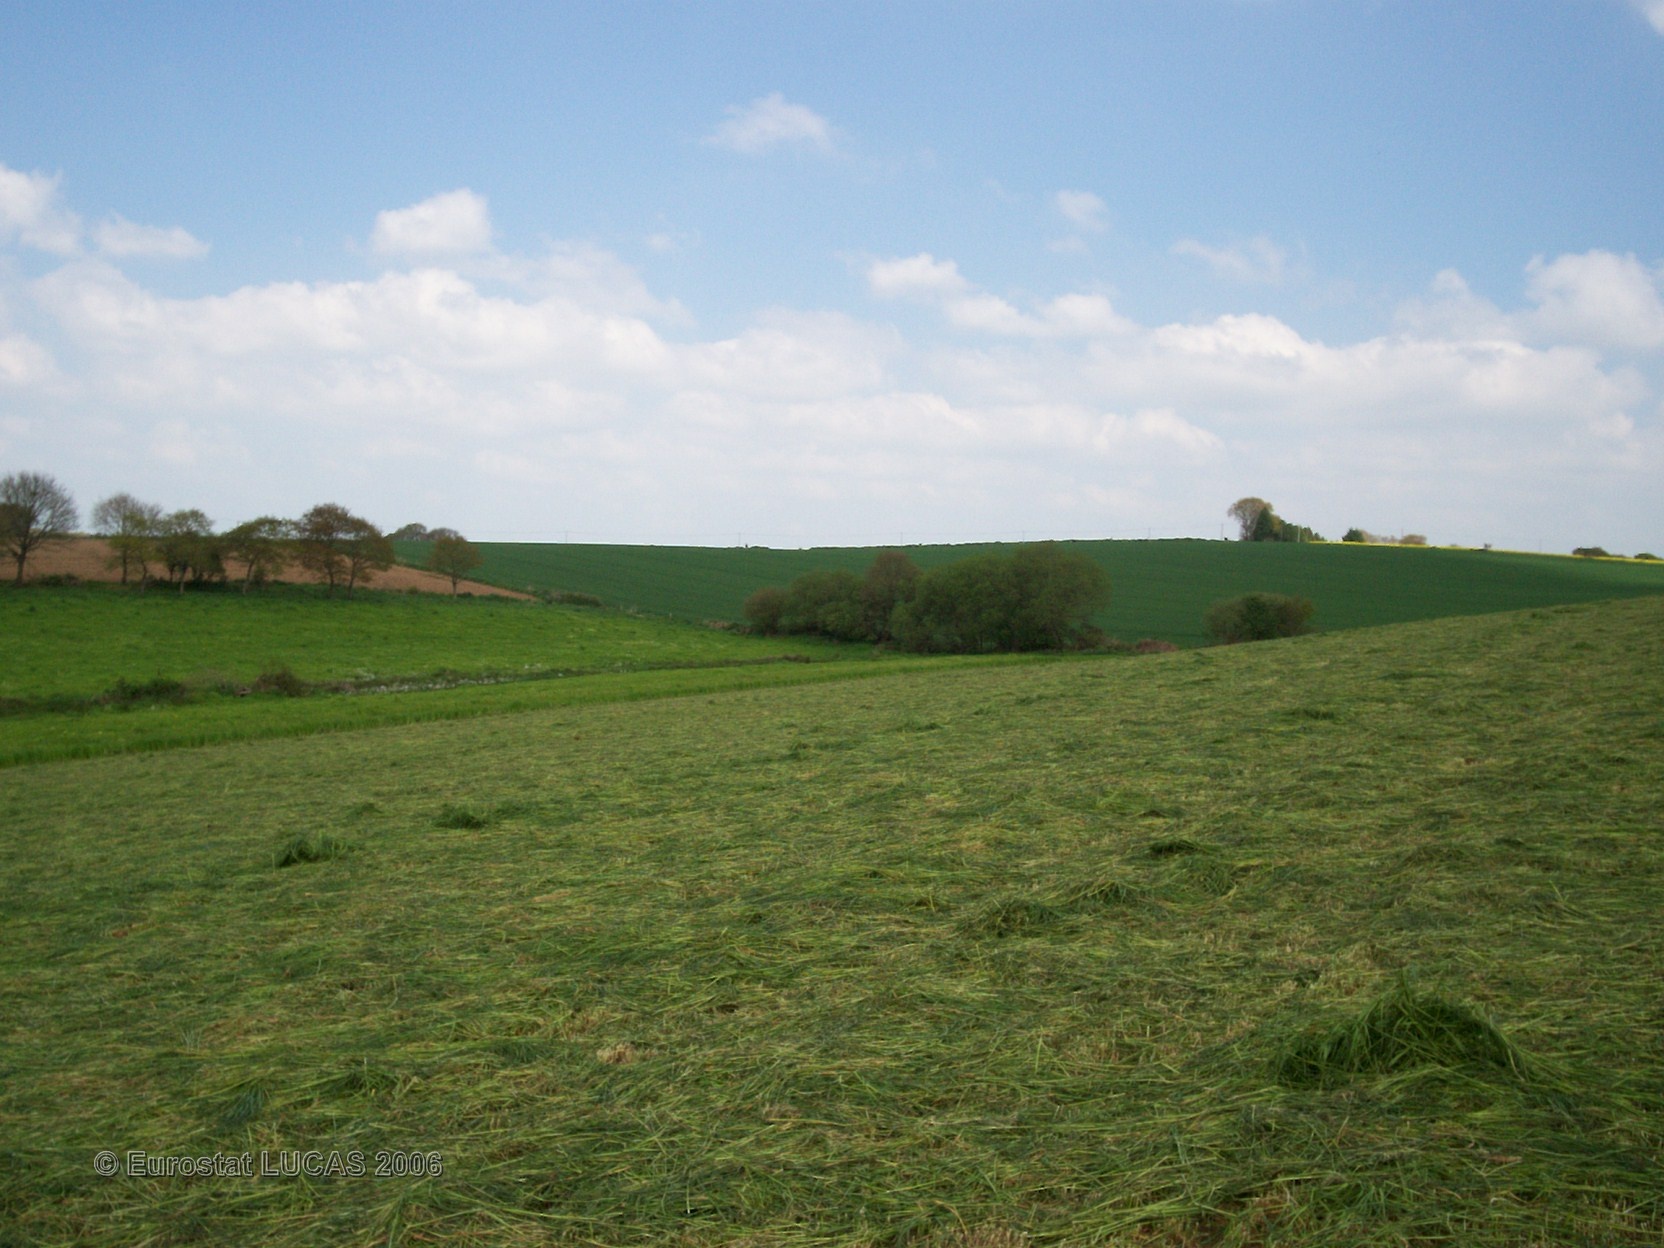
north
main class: Grassland
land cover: Grassland without tree/shrub cover
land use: Agriculture (excluding fallow land and kitchen gardens)
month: May
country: FR
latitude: 48.3347
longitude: -3.6657
